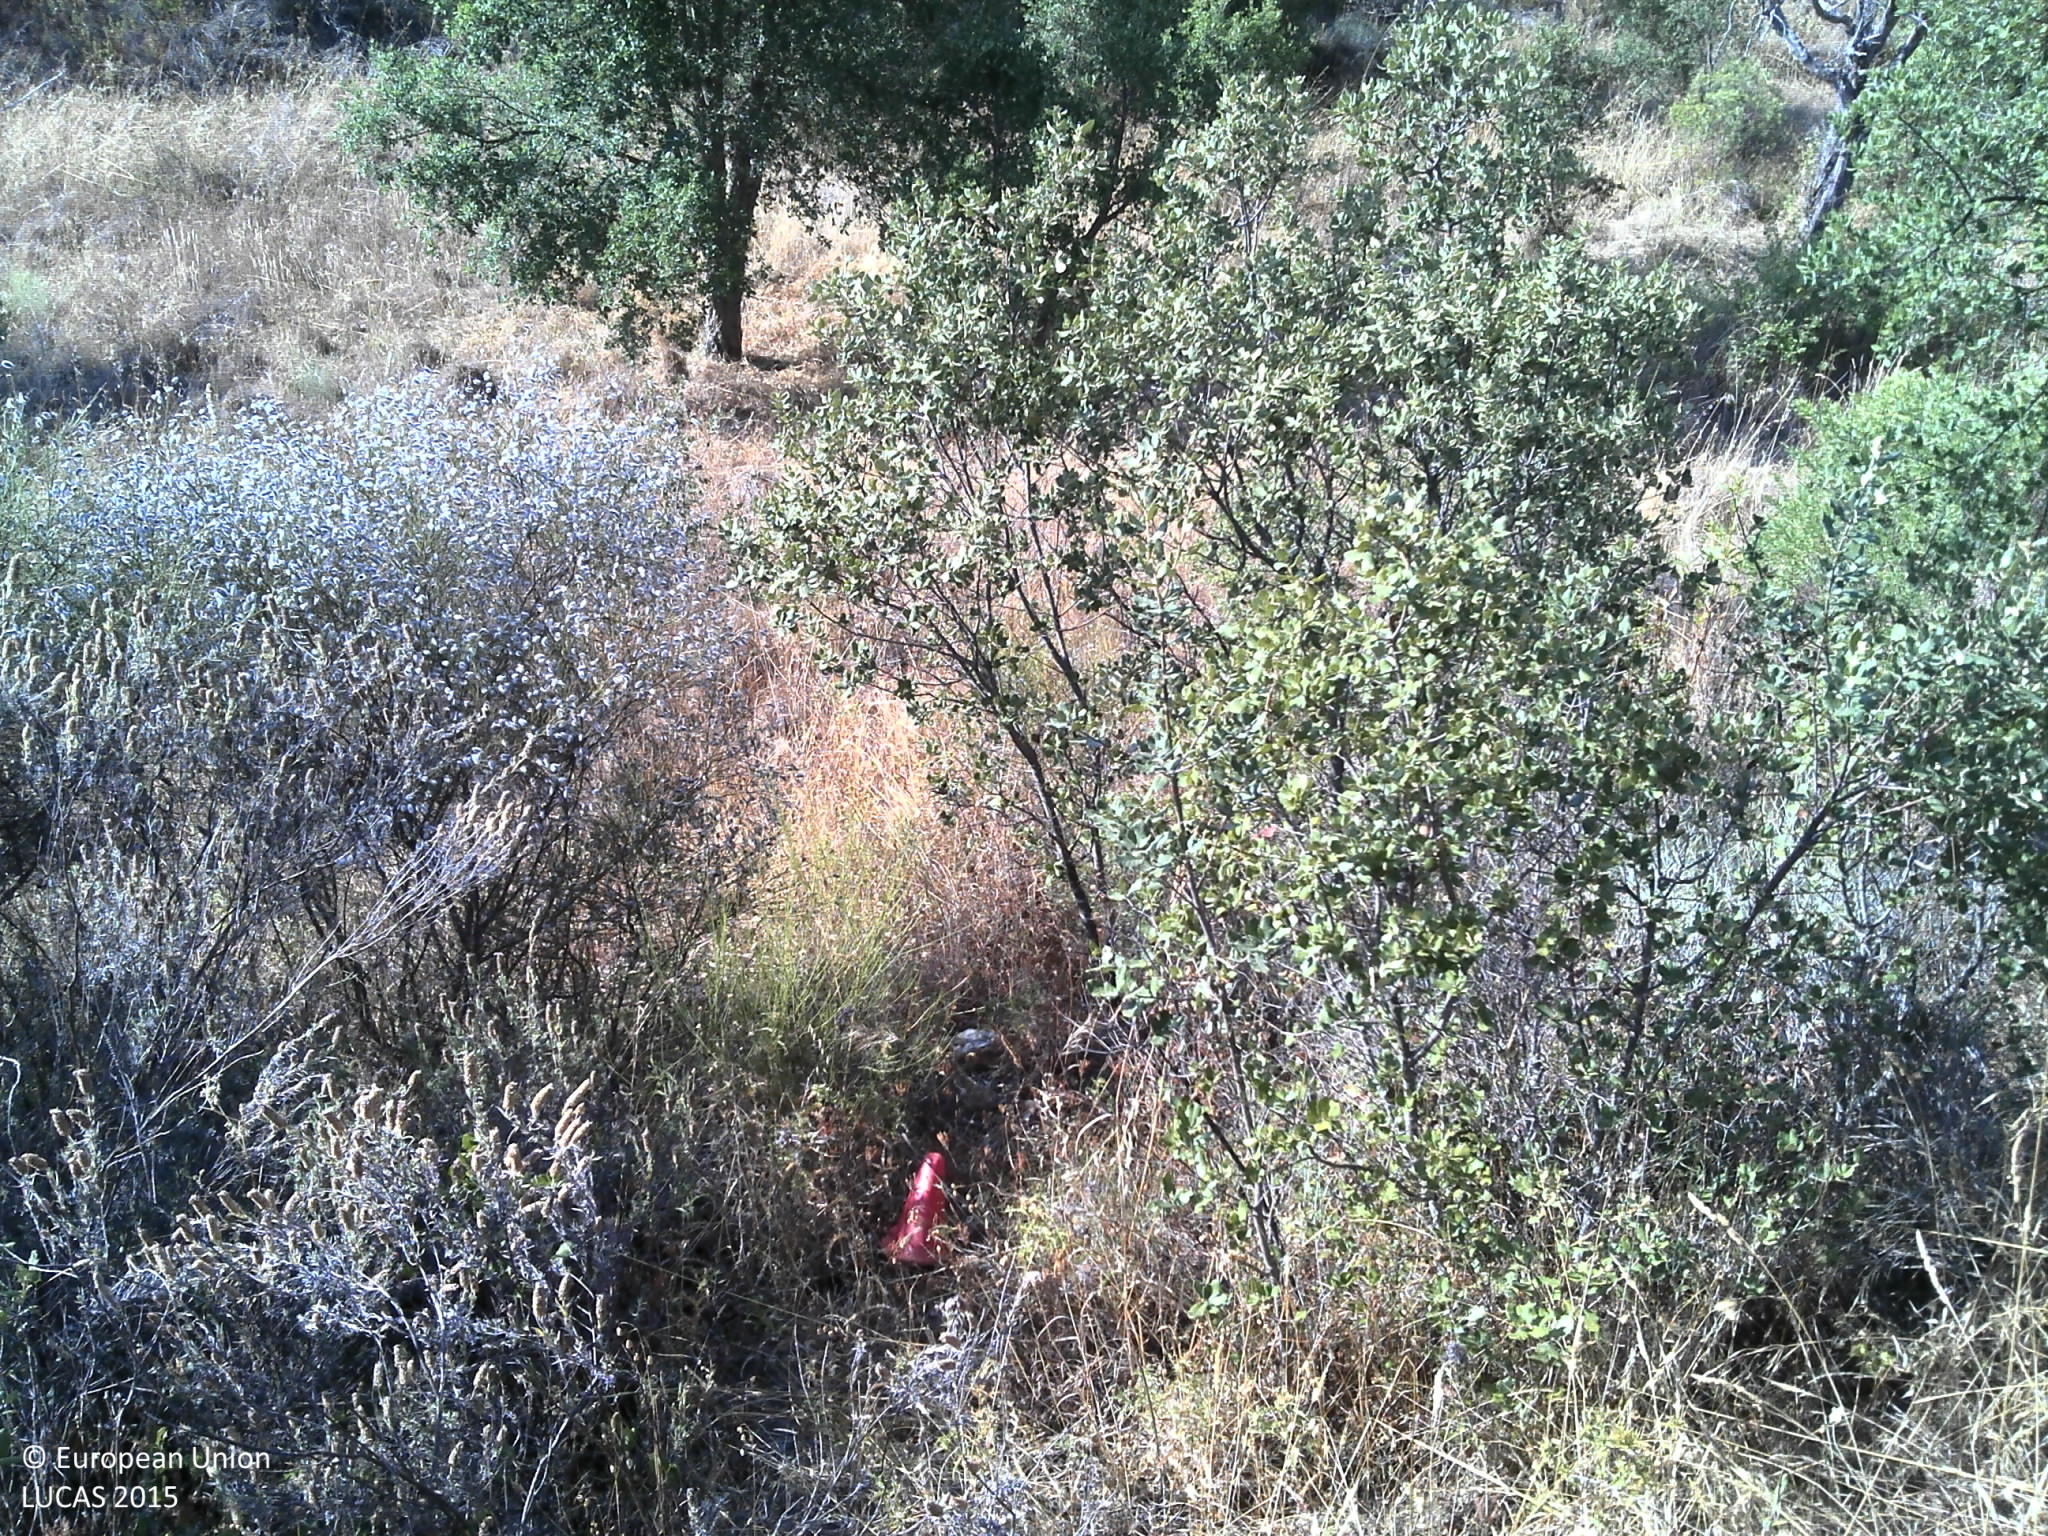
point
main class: Shrubland
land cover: Shrubland with sparse tree cover
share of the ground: > 75 %
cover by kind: shrubs 80 %, herbaceous plants 10 %, broadleaved forest trees 5 %, unconsolidated bare surface 5 %
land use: Semi-natural and natural areas not in use
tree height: < 5 m
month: July
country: PT
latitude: 39.6268
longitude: -7.7757
